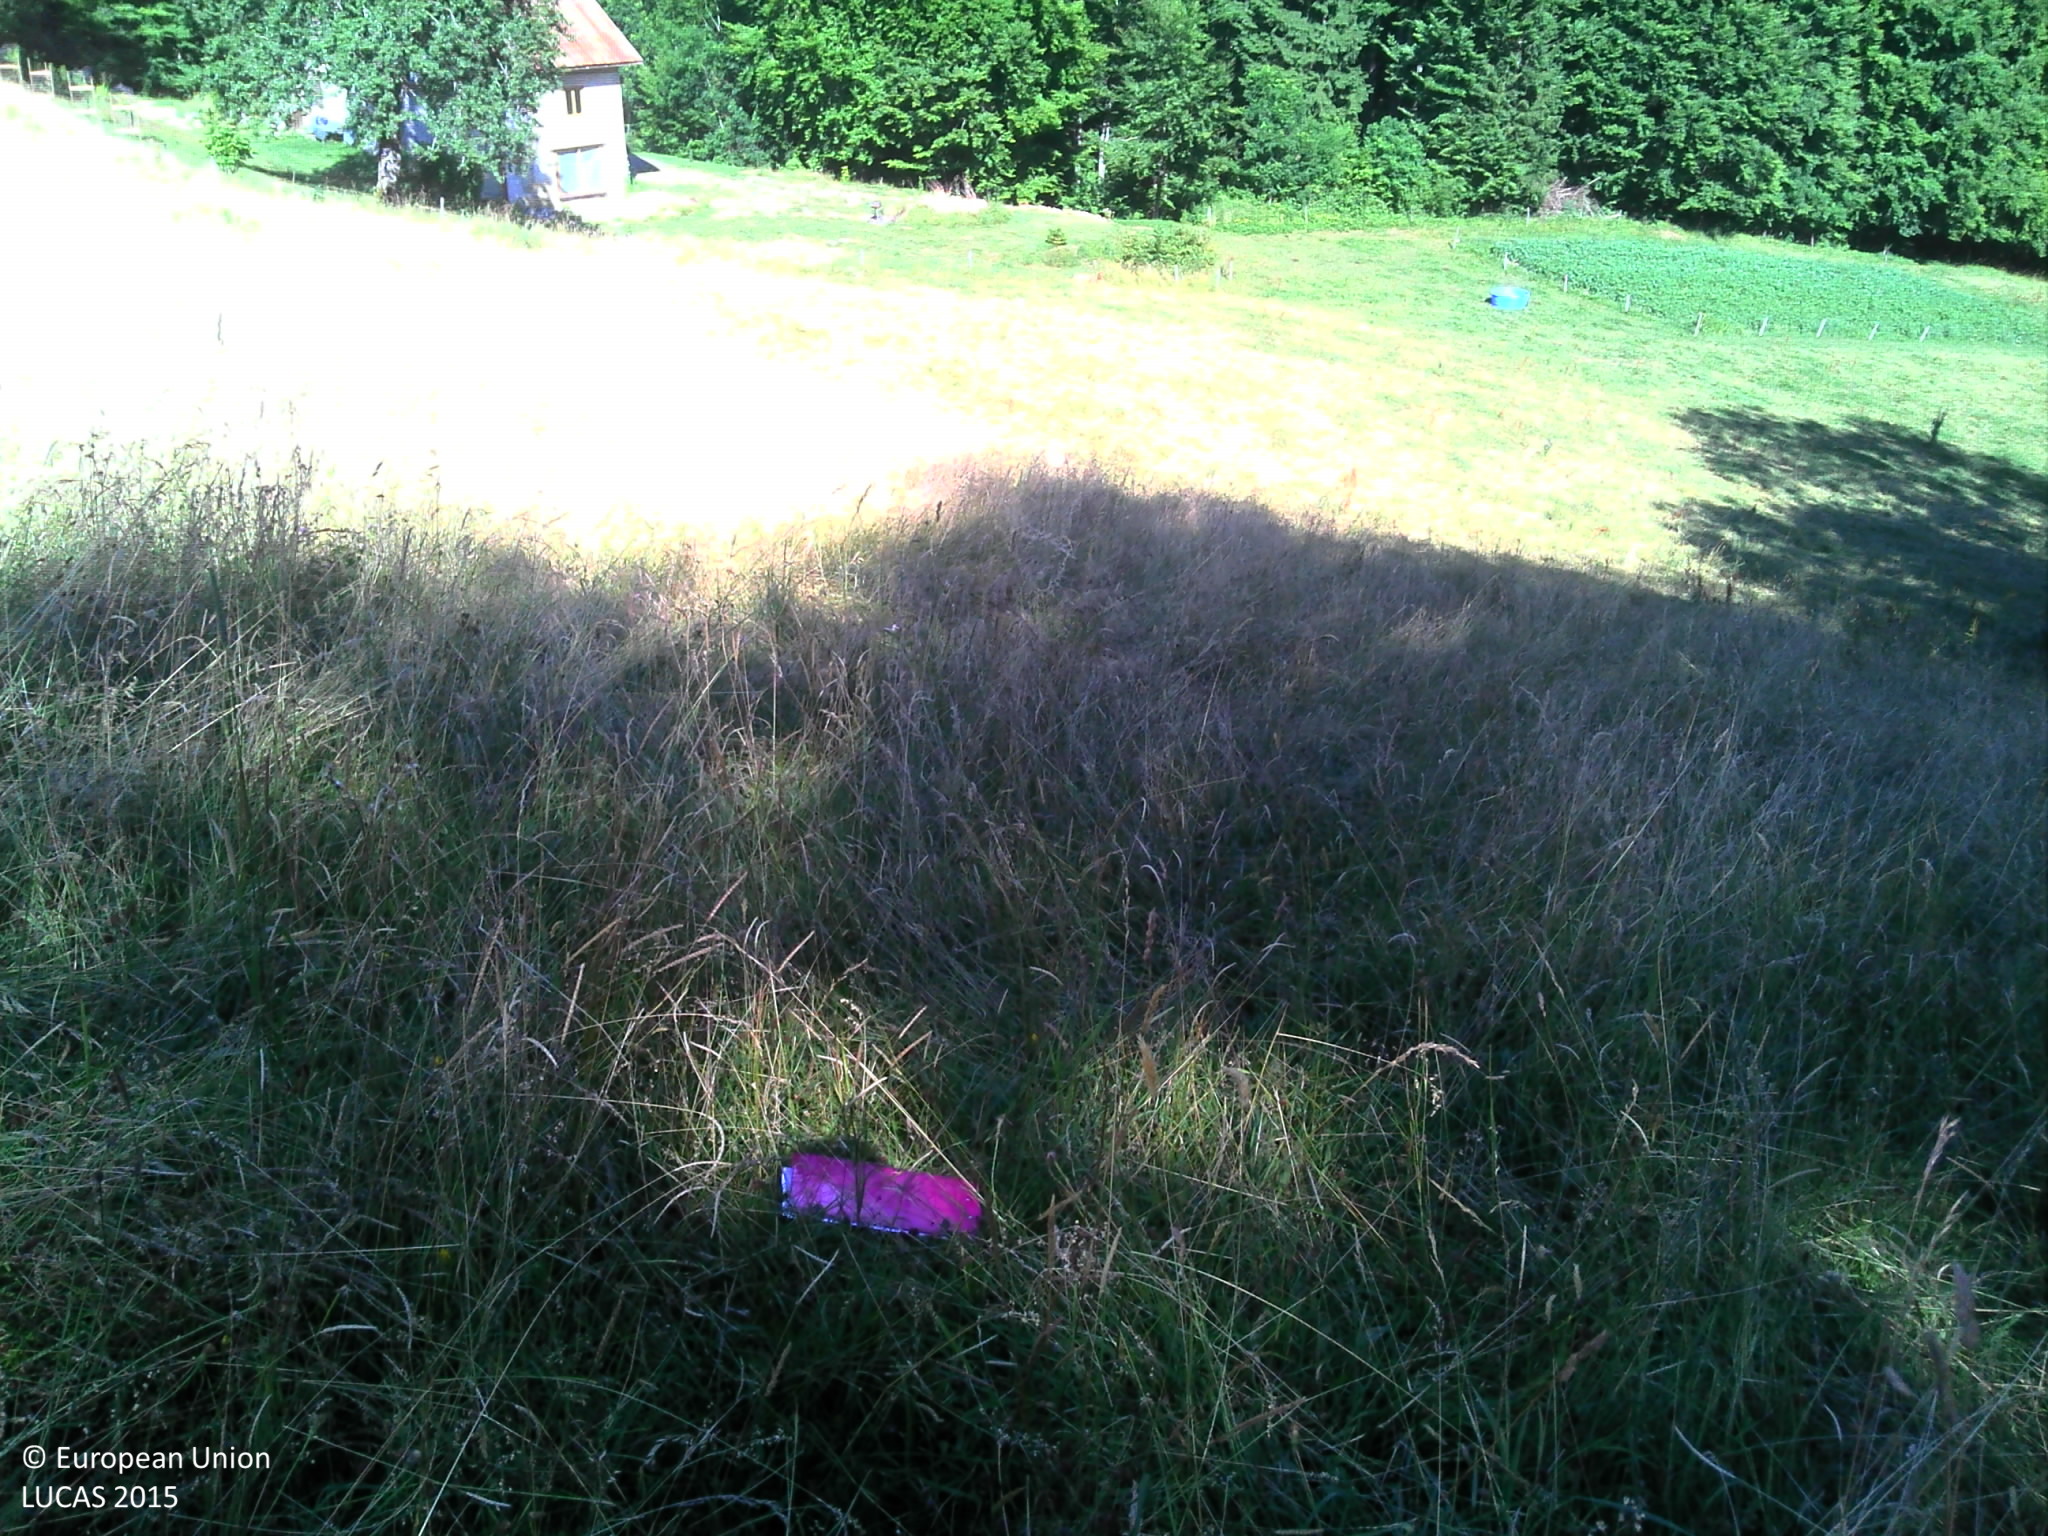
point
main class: Grassland
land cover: Grassland without tree/shrub cover
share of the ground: > 75 %
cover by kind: herbaceous plants 100 %
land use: Agriculture (excluding fallow land and kitchen gardens)
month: July
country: FR
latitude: 46.2378
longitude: 6.4372
